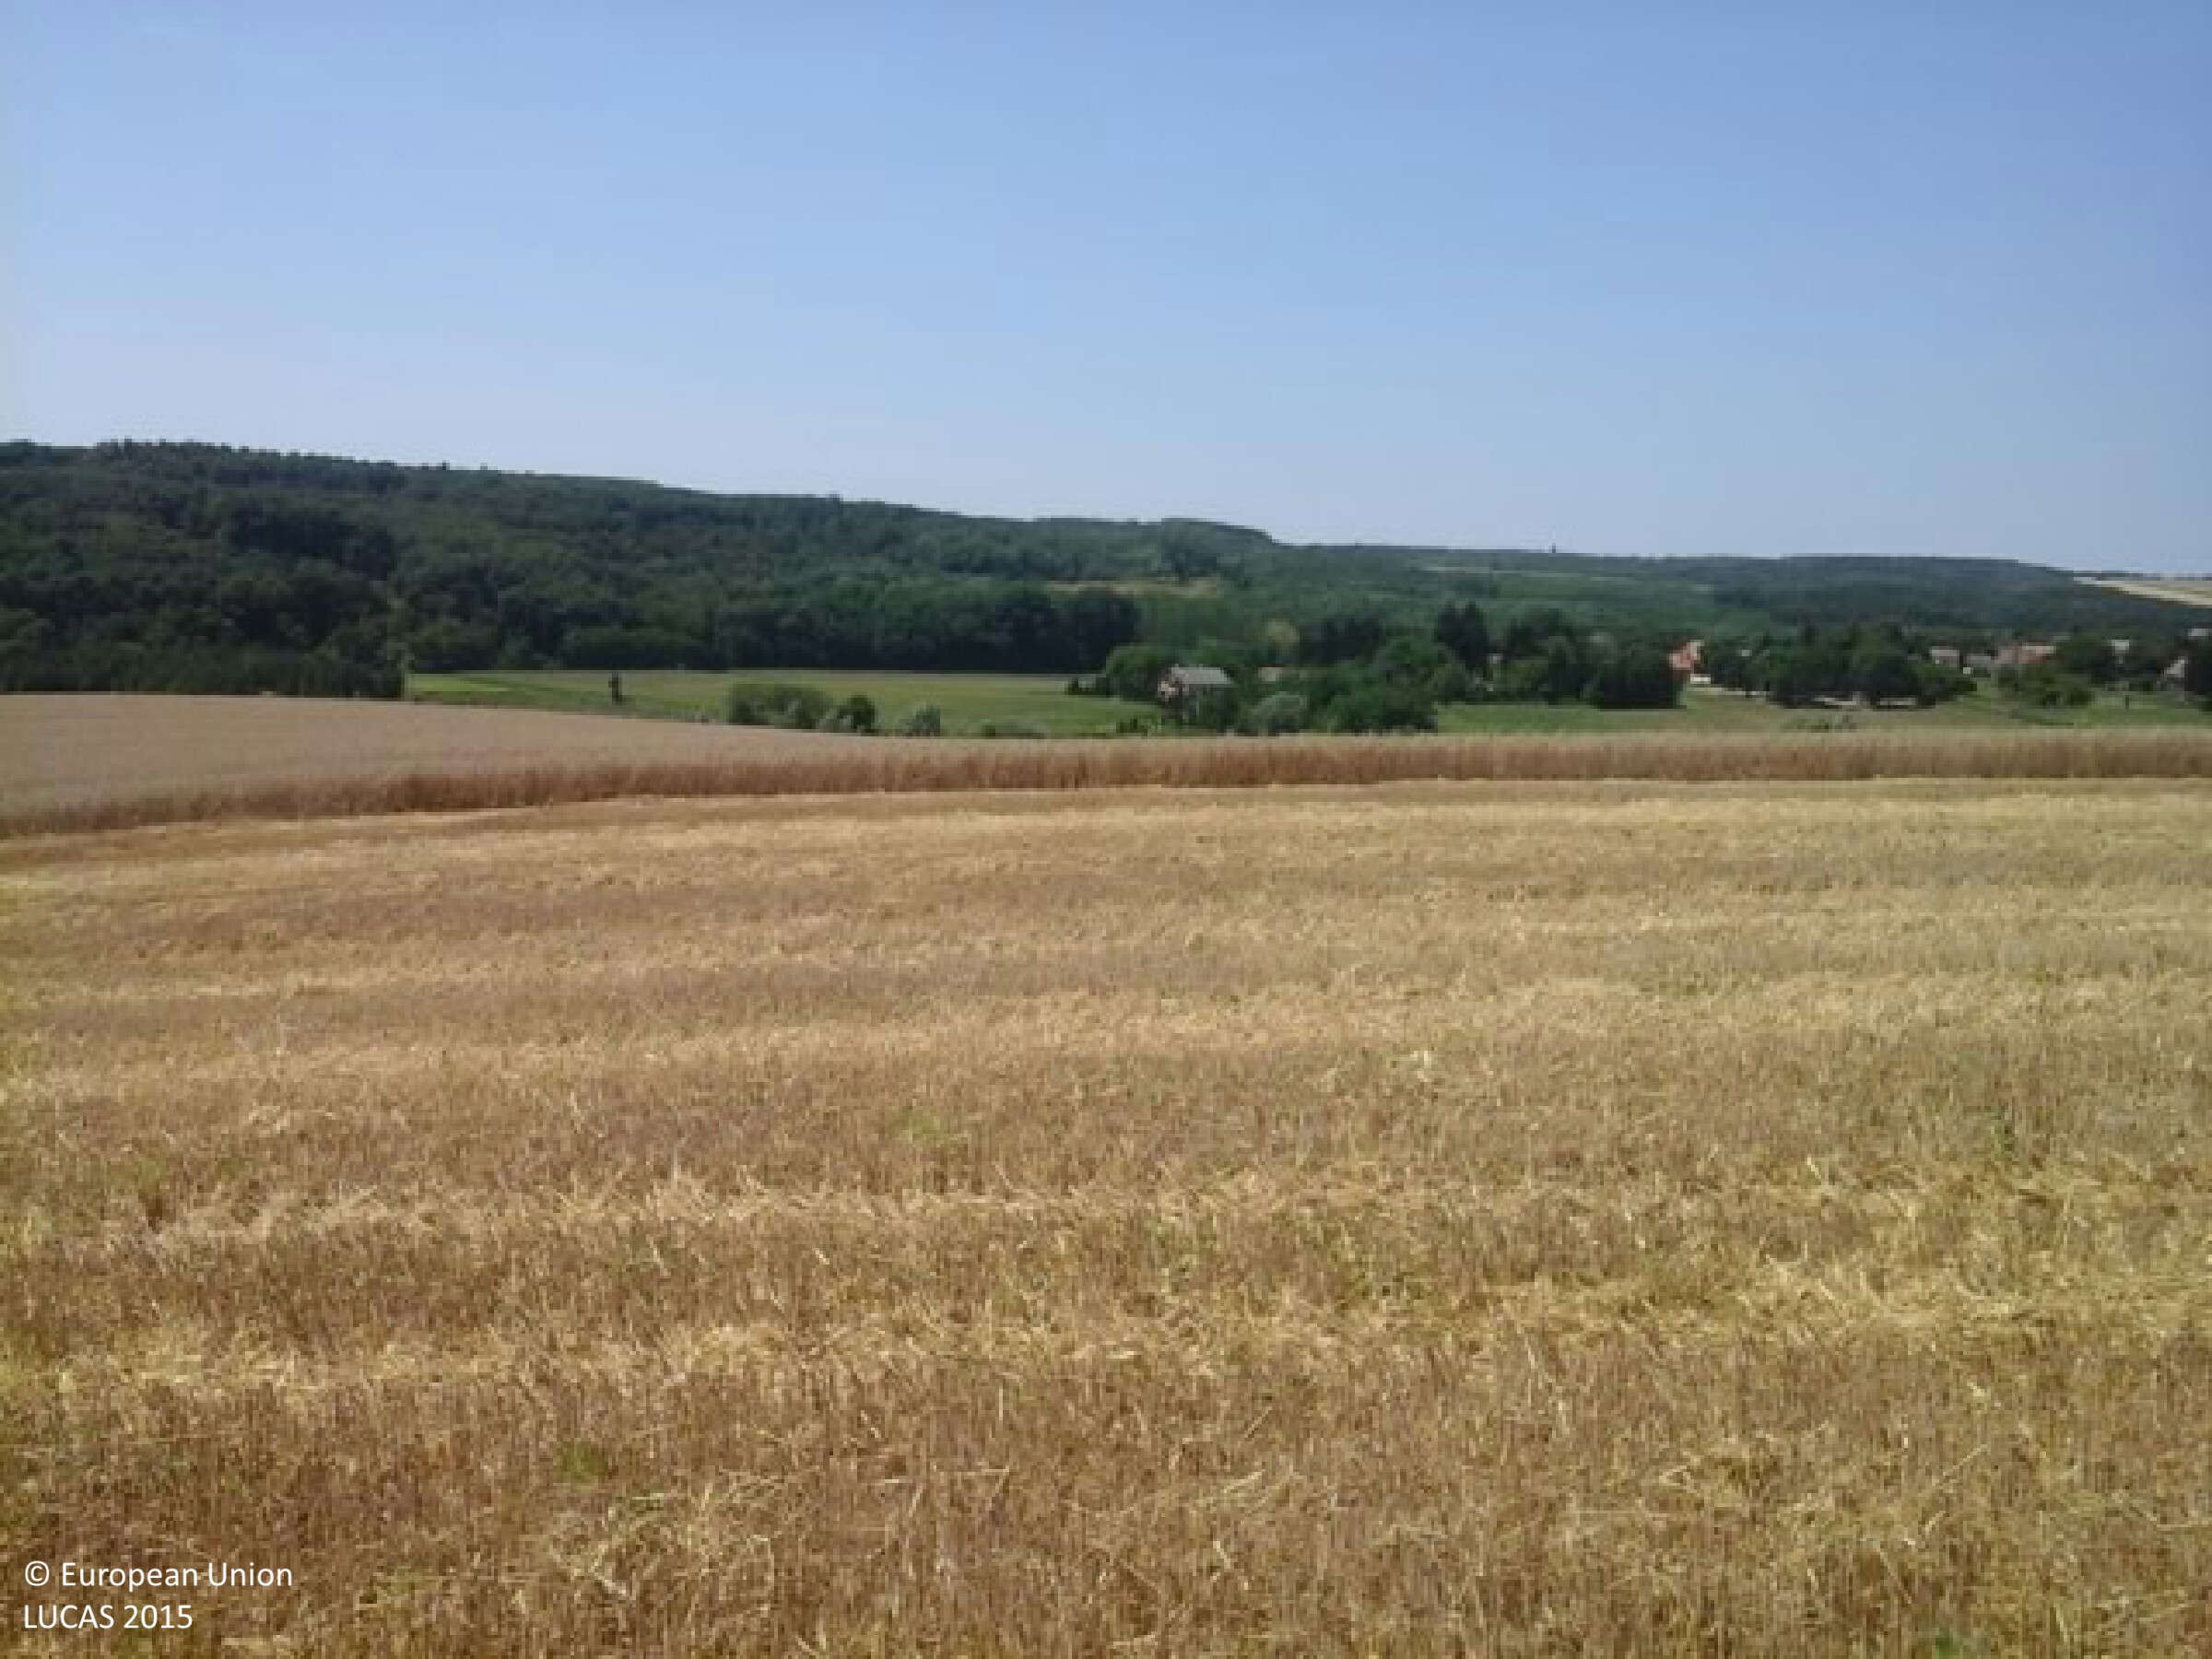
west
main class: Cropland
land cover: Common wheat
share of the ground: > 75 %
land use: Agriculture (excluding fallow land and kitchen gardens)
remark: Harvested field
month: July
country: HU
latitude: 46.2829
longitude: 17.0238
